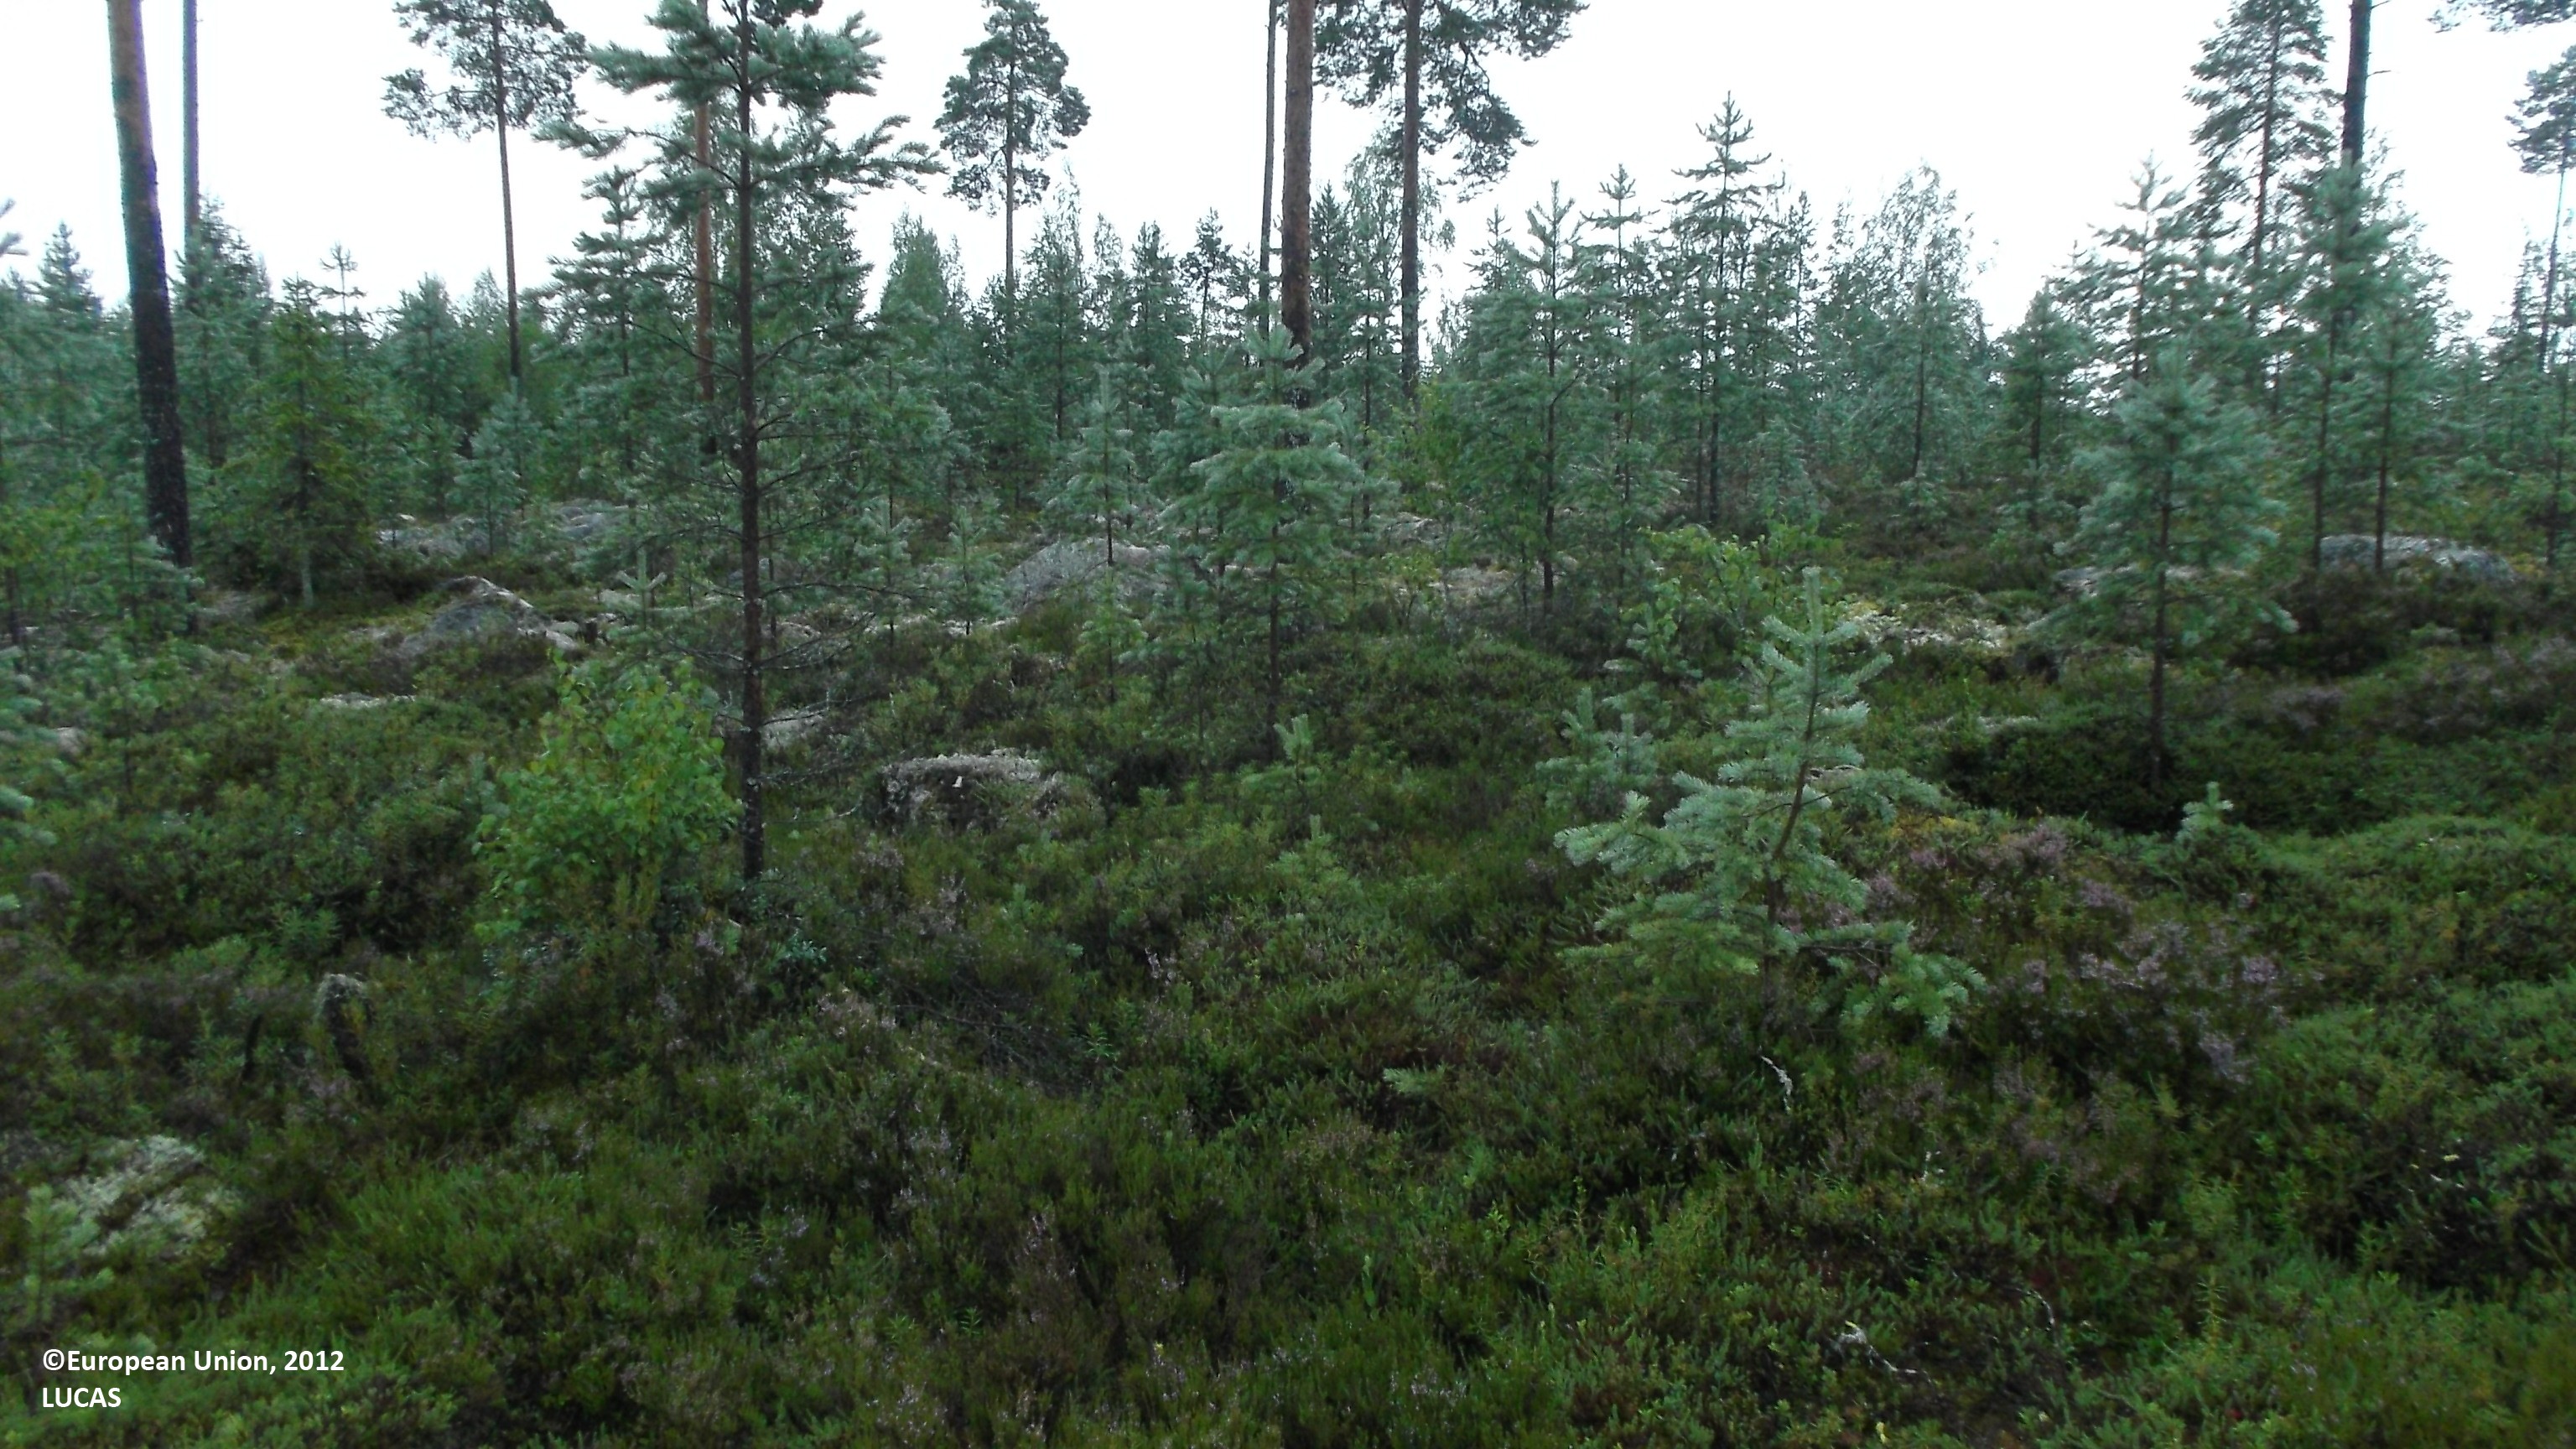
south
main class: Woodland
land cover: Pine dominated coniferous woodland
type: boreal forest
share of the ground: 10 - 25 %
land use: Forestry
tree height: < 5 m
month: August
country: FI
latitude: 63.2343
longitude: 23.8636
